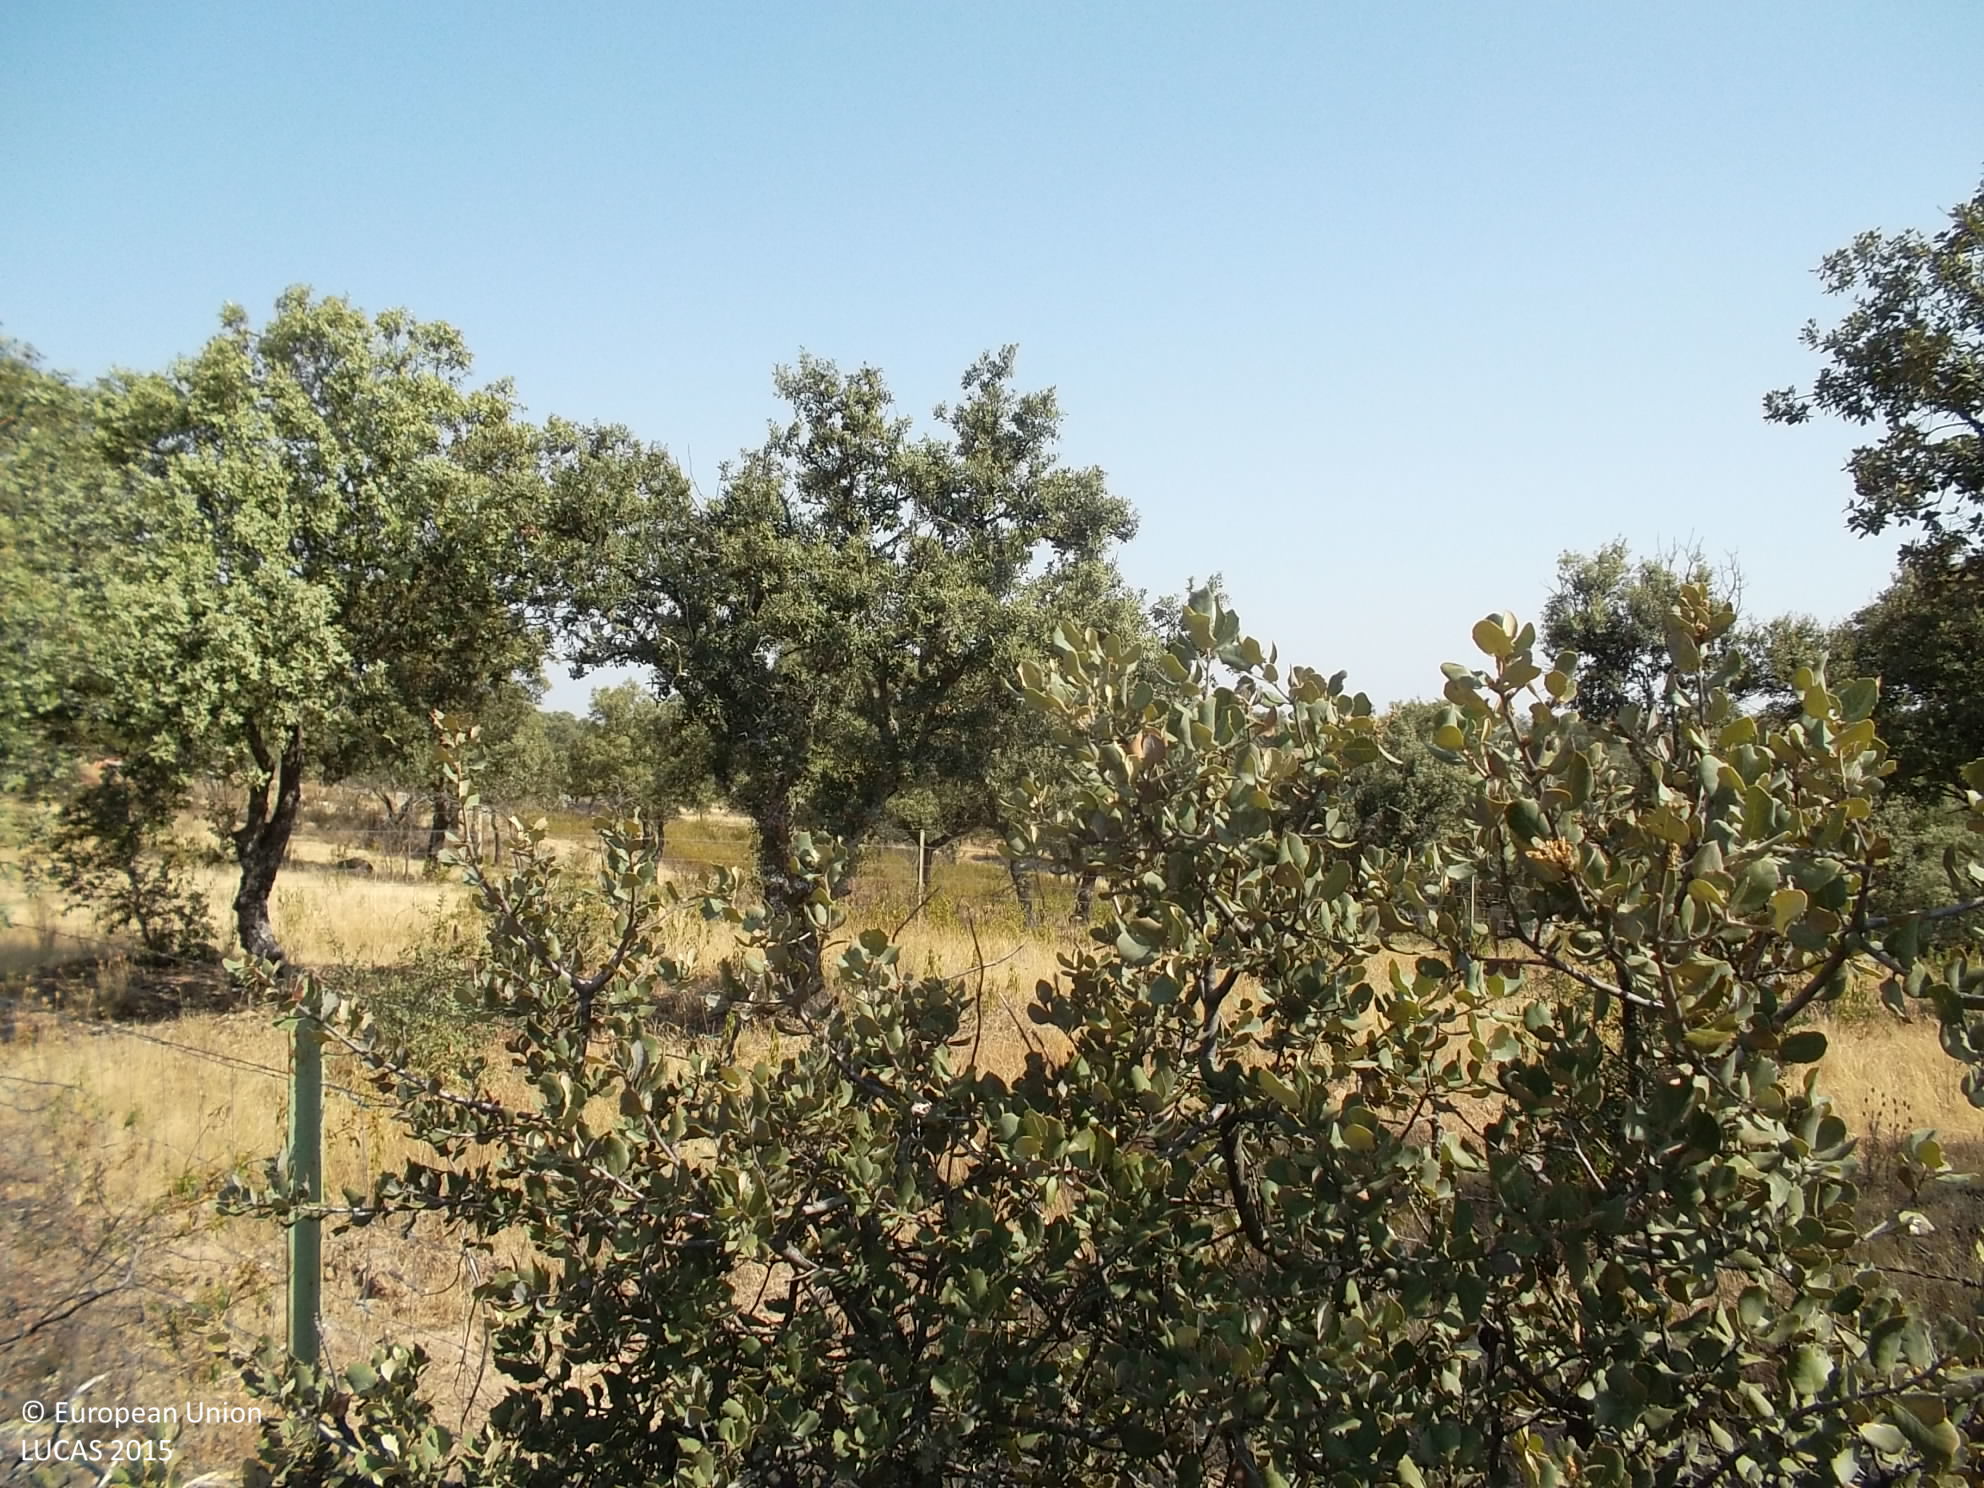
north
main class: Shrubland
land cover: Shrubland with sparse tree cover
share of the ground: 25 - 50 %
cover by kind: herbaceous plants 55 %, shrubs 40 %, broadleaved forest trees 5 %
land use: Semi-natural and natural areas not in use
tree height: < 5 m
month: July
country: ES
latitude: 38.2172
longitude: -4.6957
